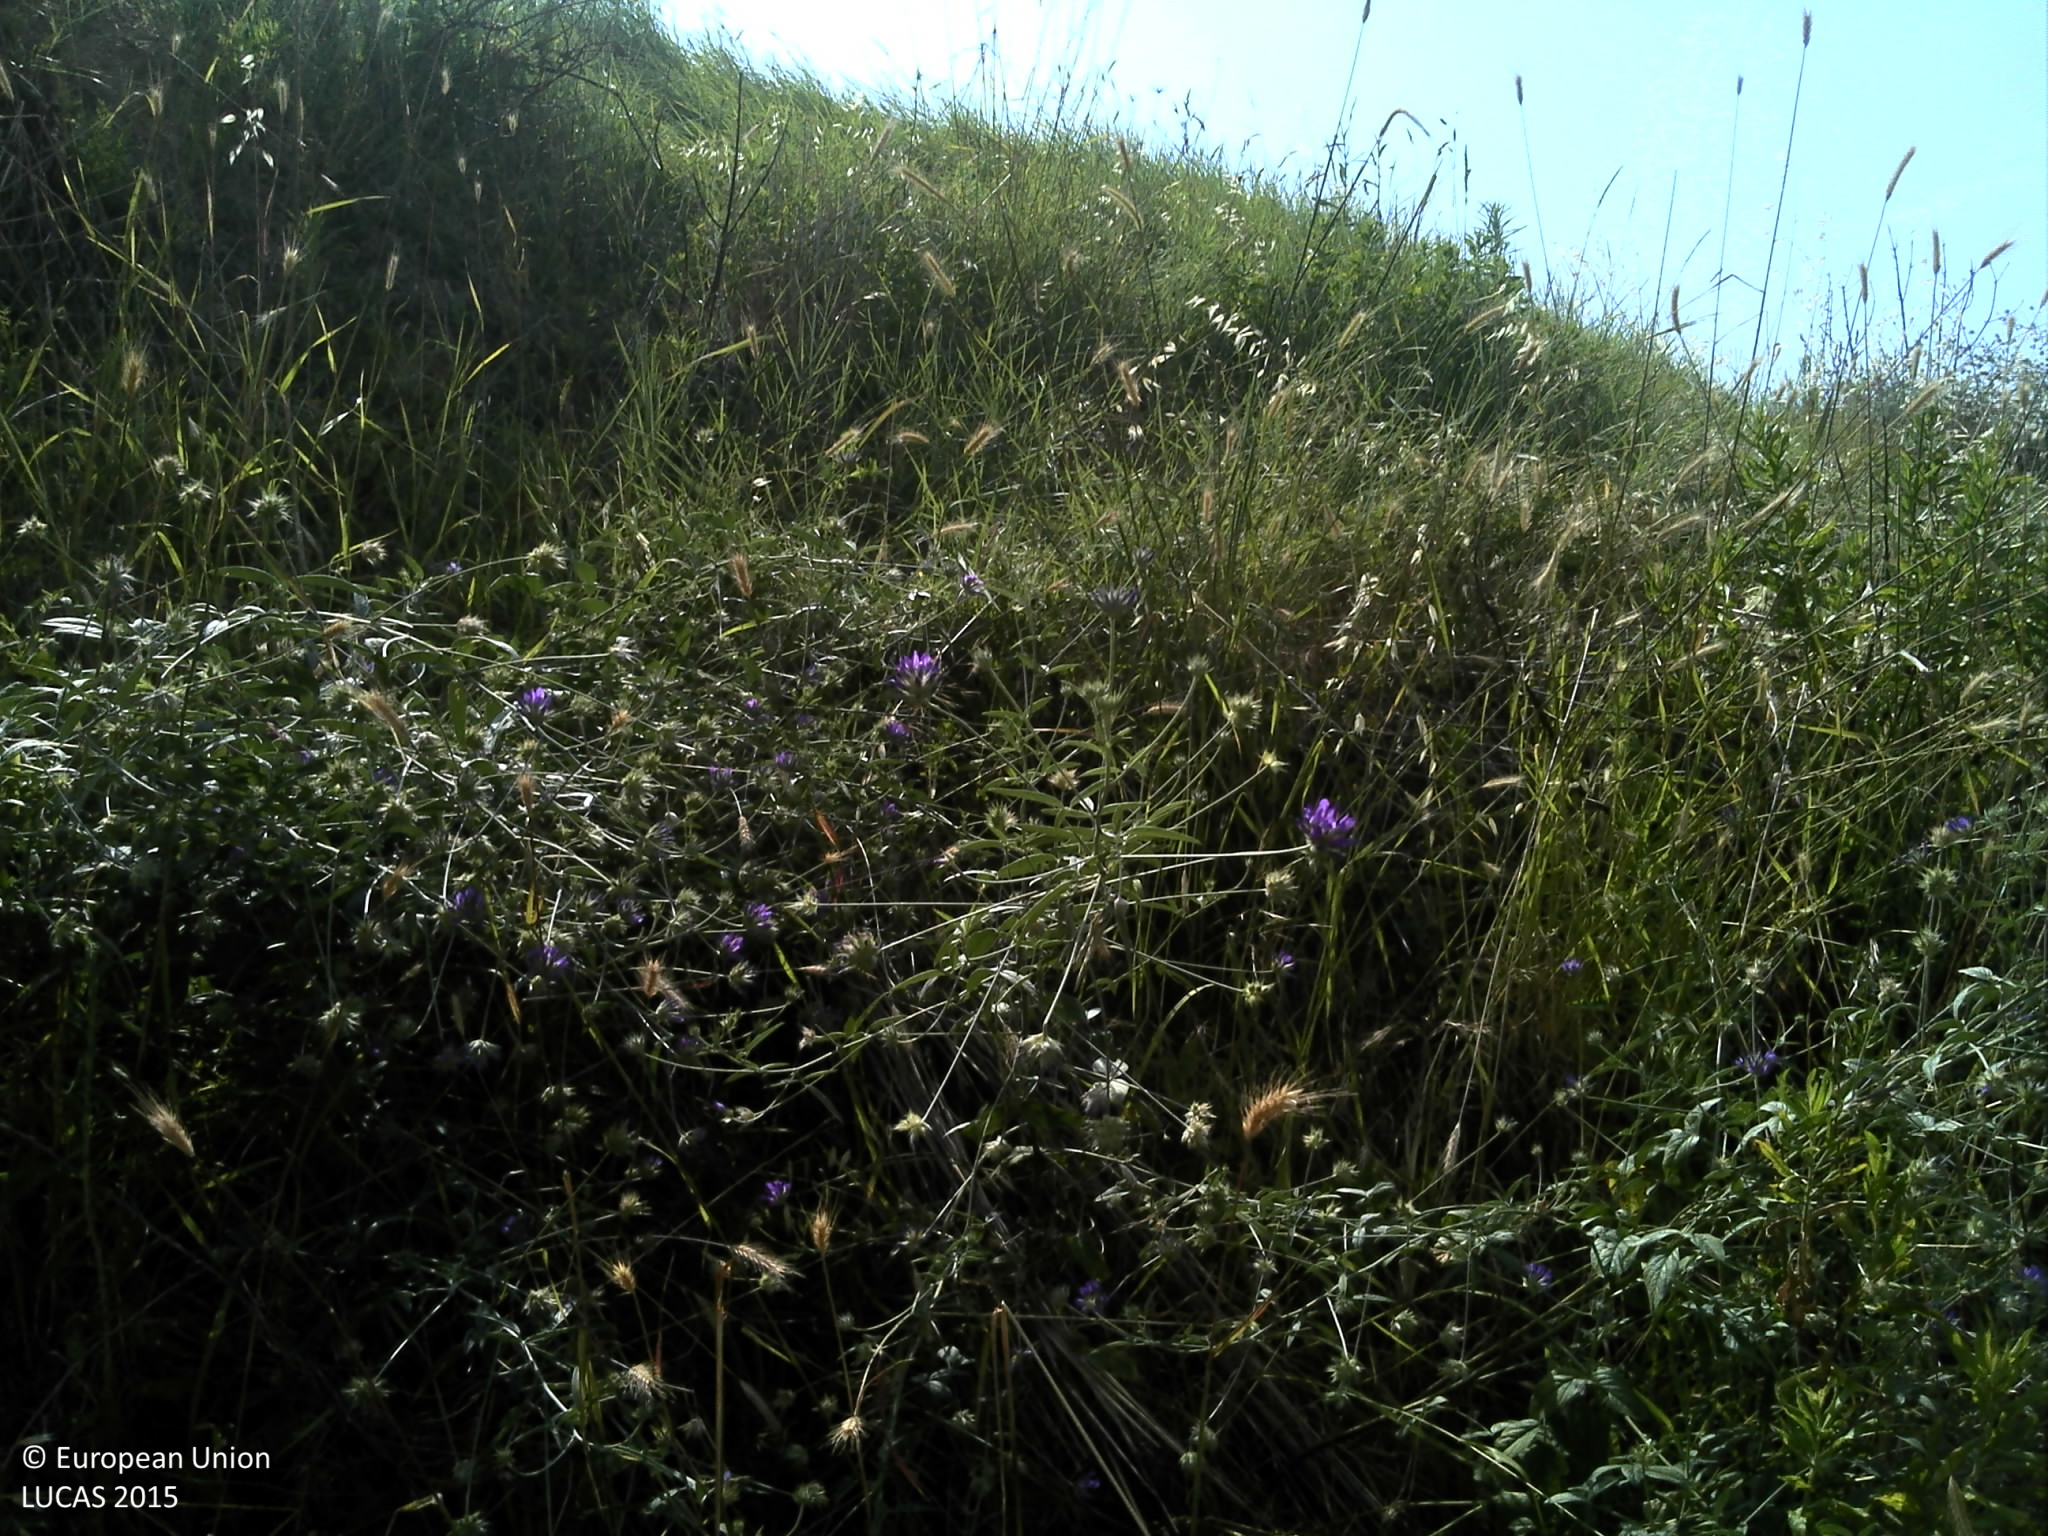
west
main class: Grassland
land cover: Grassland without tree/shrub cover
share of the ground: > 75 %
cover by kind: herbaceous plants 80 %, unconsolidated bare surface 15 %, shrubs 5 %
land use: Abandoned areas
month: June
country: HR
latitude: 43.5281
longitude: 16.2639
